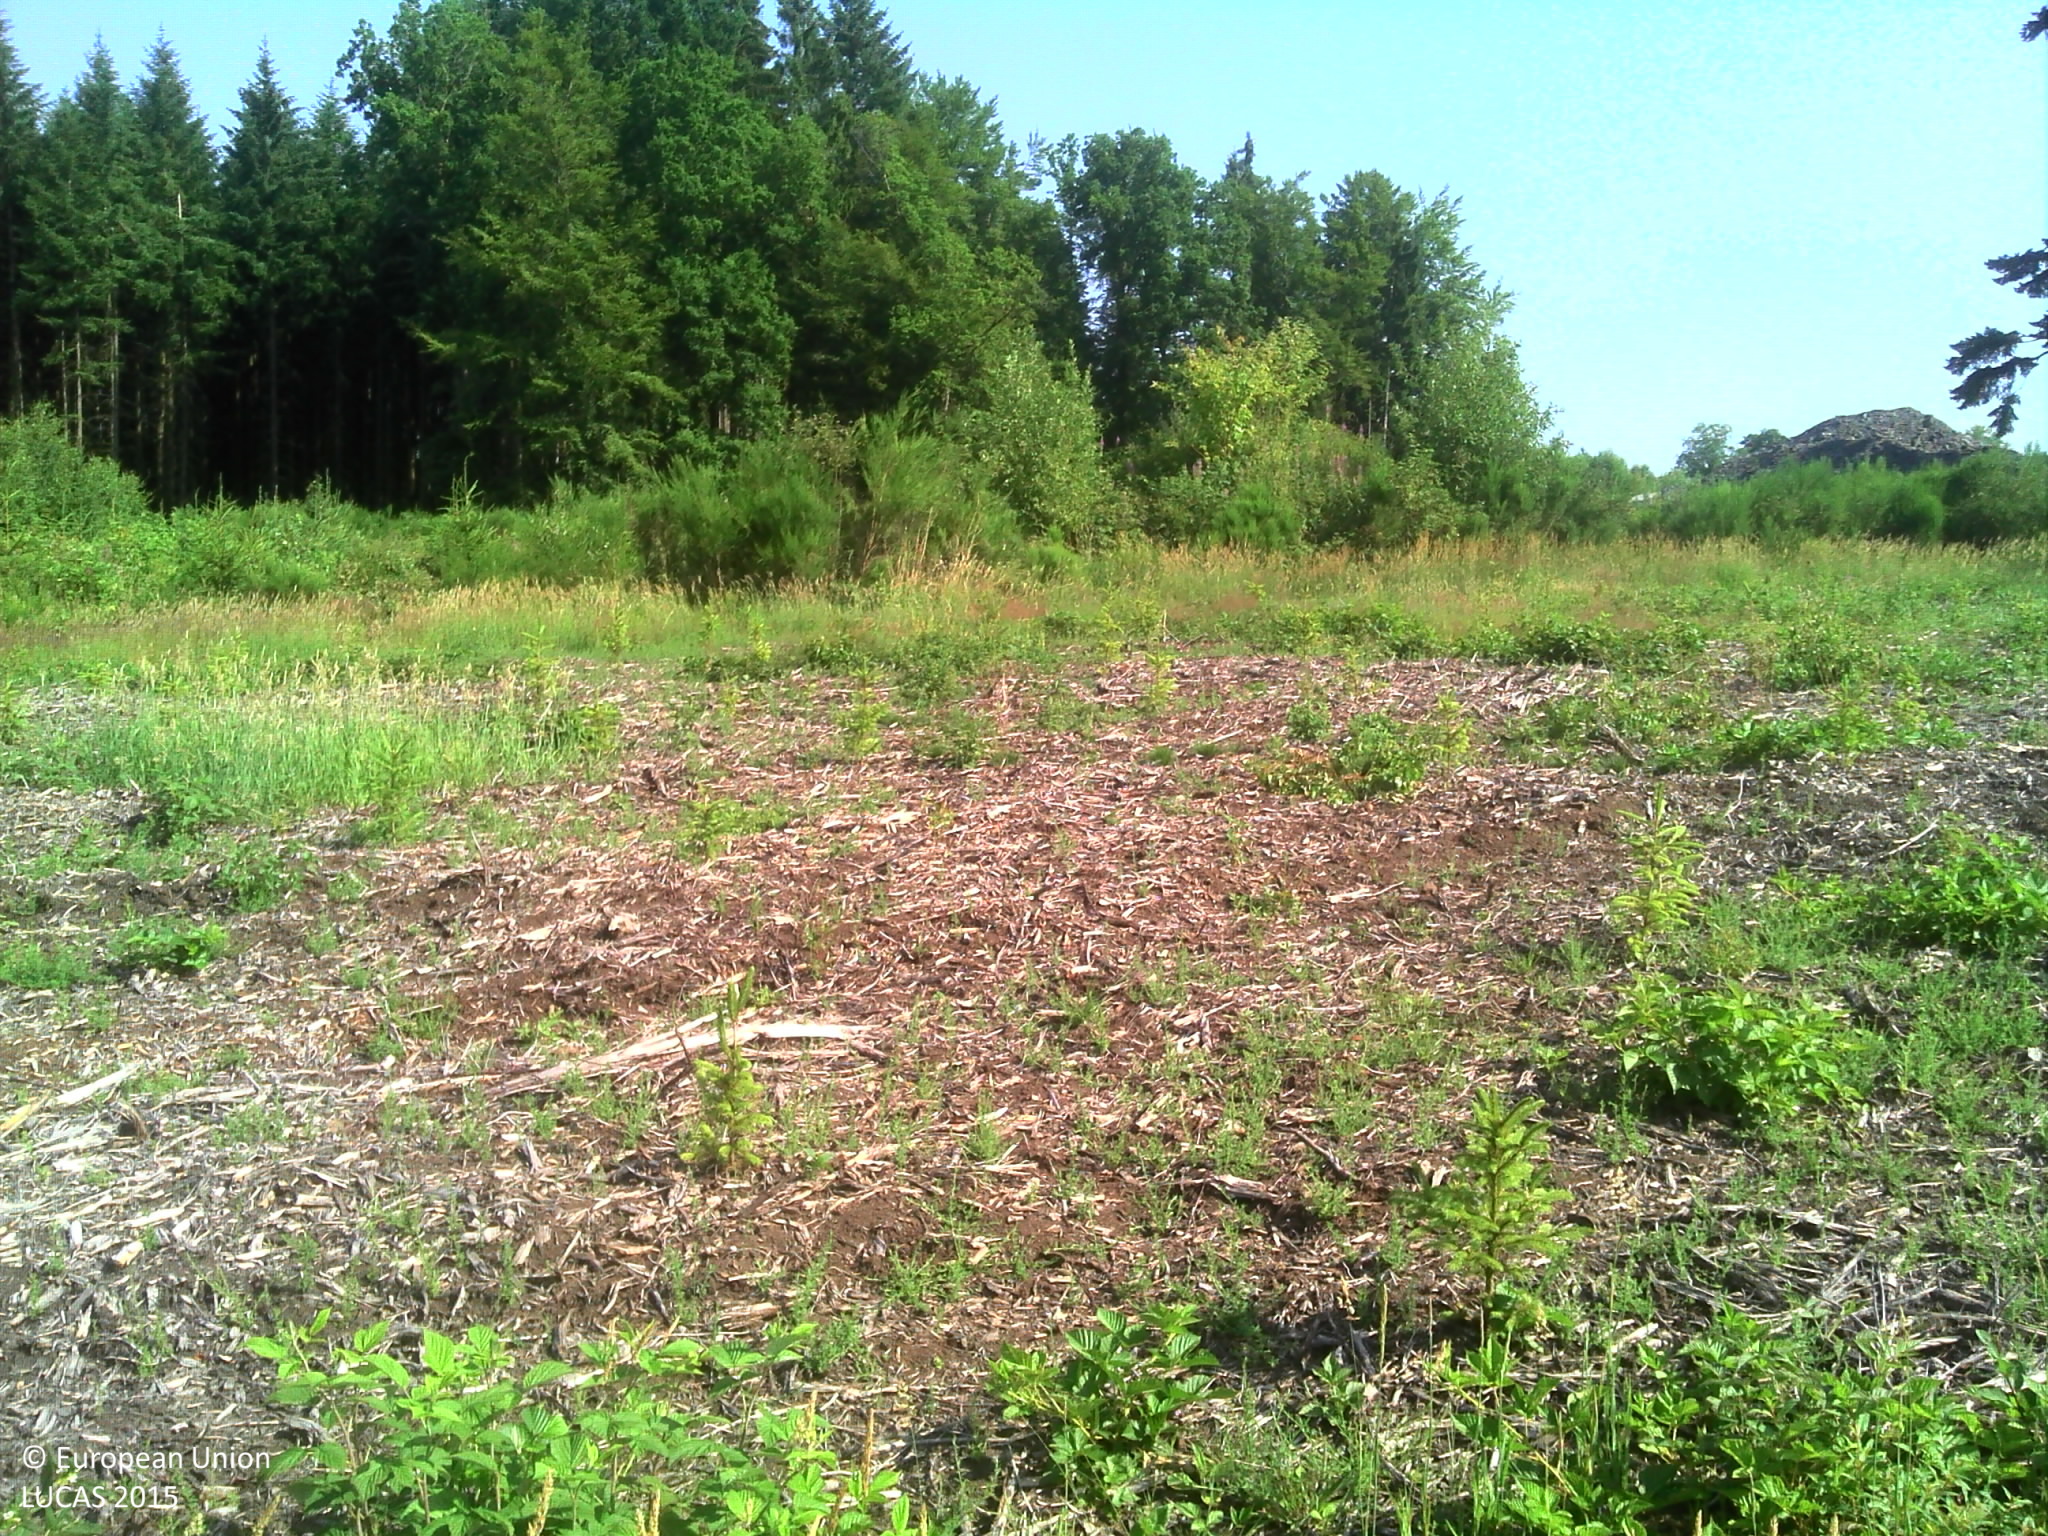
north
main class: Grassland
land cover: Spontaneously vegetated surfaces
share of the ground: 50 - 75 %
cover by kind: herbaceous plants 60 %, unconsolidated bare surface 35 %, shrubs 5 %
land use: Forestry
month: July
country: BE
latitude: 49.9567
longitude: 5.6358
